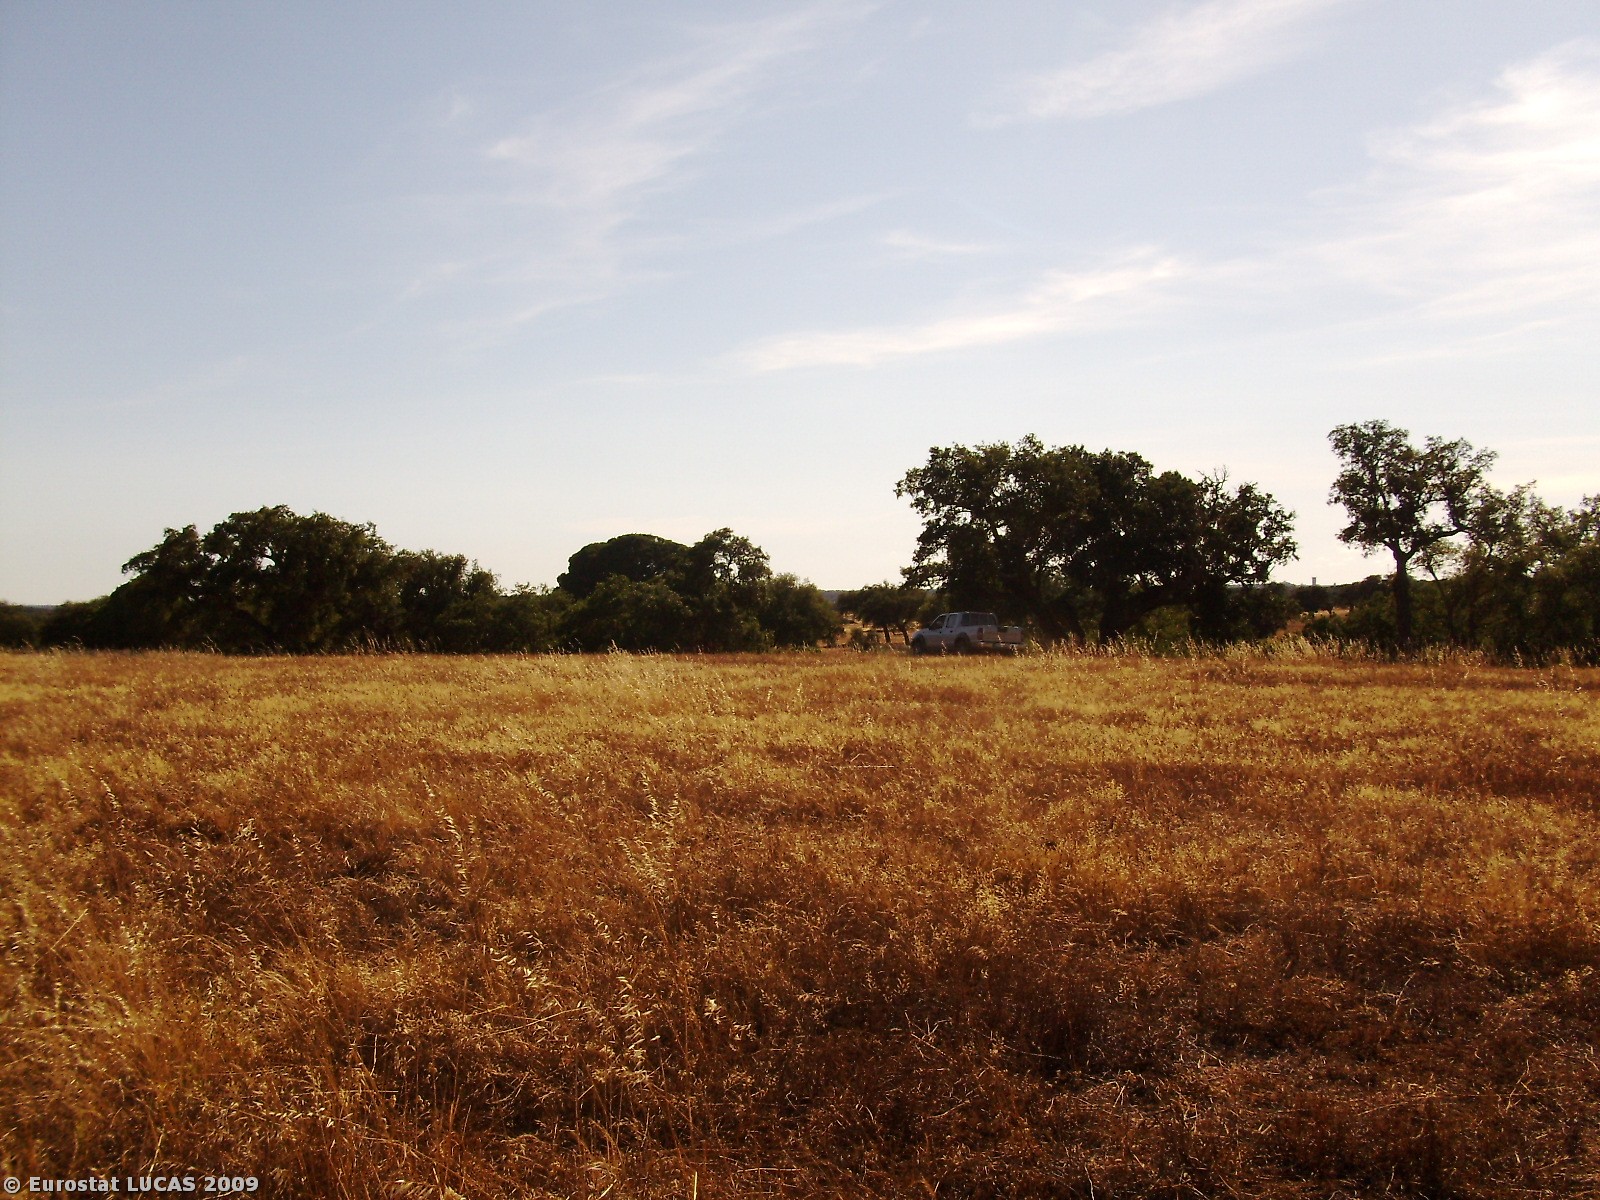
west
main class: Grassland
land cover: Grassland without tree/shrub cover
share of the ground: > 75 %
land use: Agriculture (excluding fallow land and kitchen gardens)
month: June
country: PT
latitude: 37.9991
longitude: -8.3625
